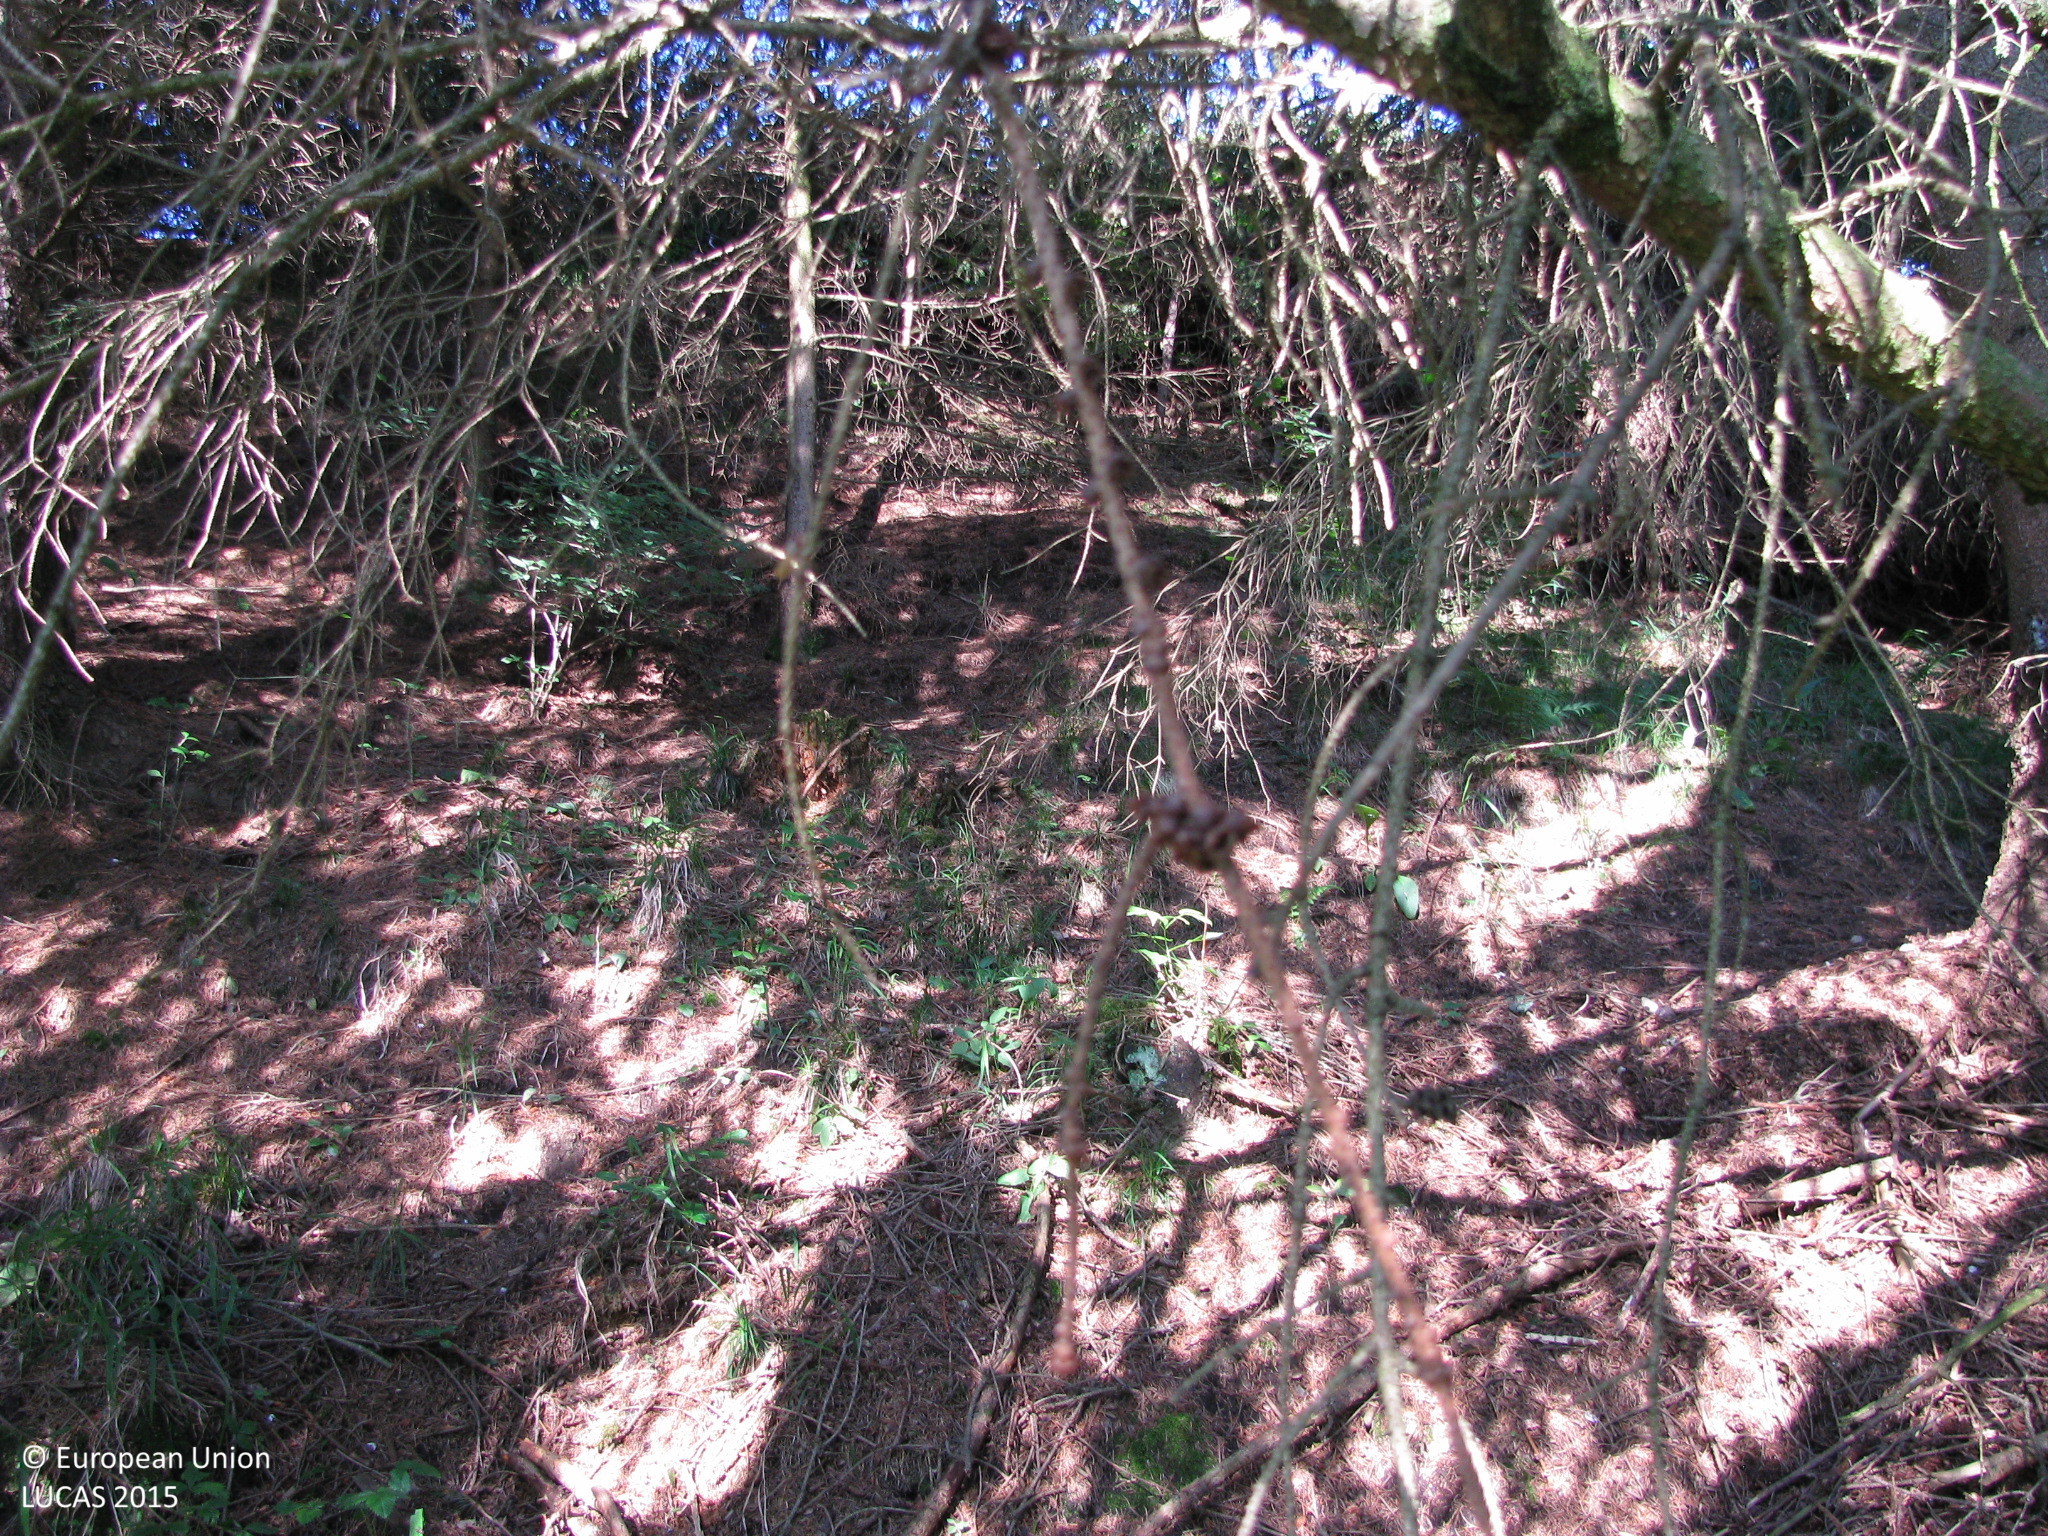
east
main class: Woodland
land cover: Spruce dominated coniferous woodland
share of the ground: > 75 %
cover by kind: coniferous forest trees 95 %, herbaceous plants 5 %
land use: Forestry
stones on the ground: < 10 %
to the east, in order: Spruce dominated coniferous woodland; Grassland without tree/shrub cover; Electric lines; Grassland without tree/shrub cover
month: July
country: AT
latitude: 47.1628
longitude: 14.8138
